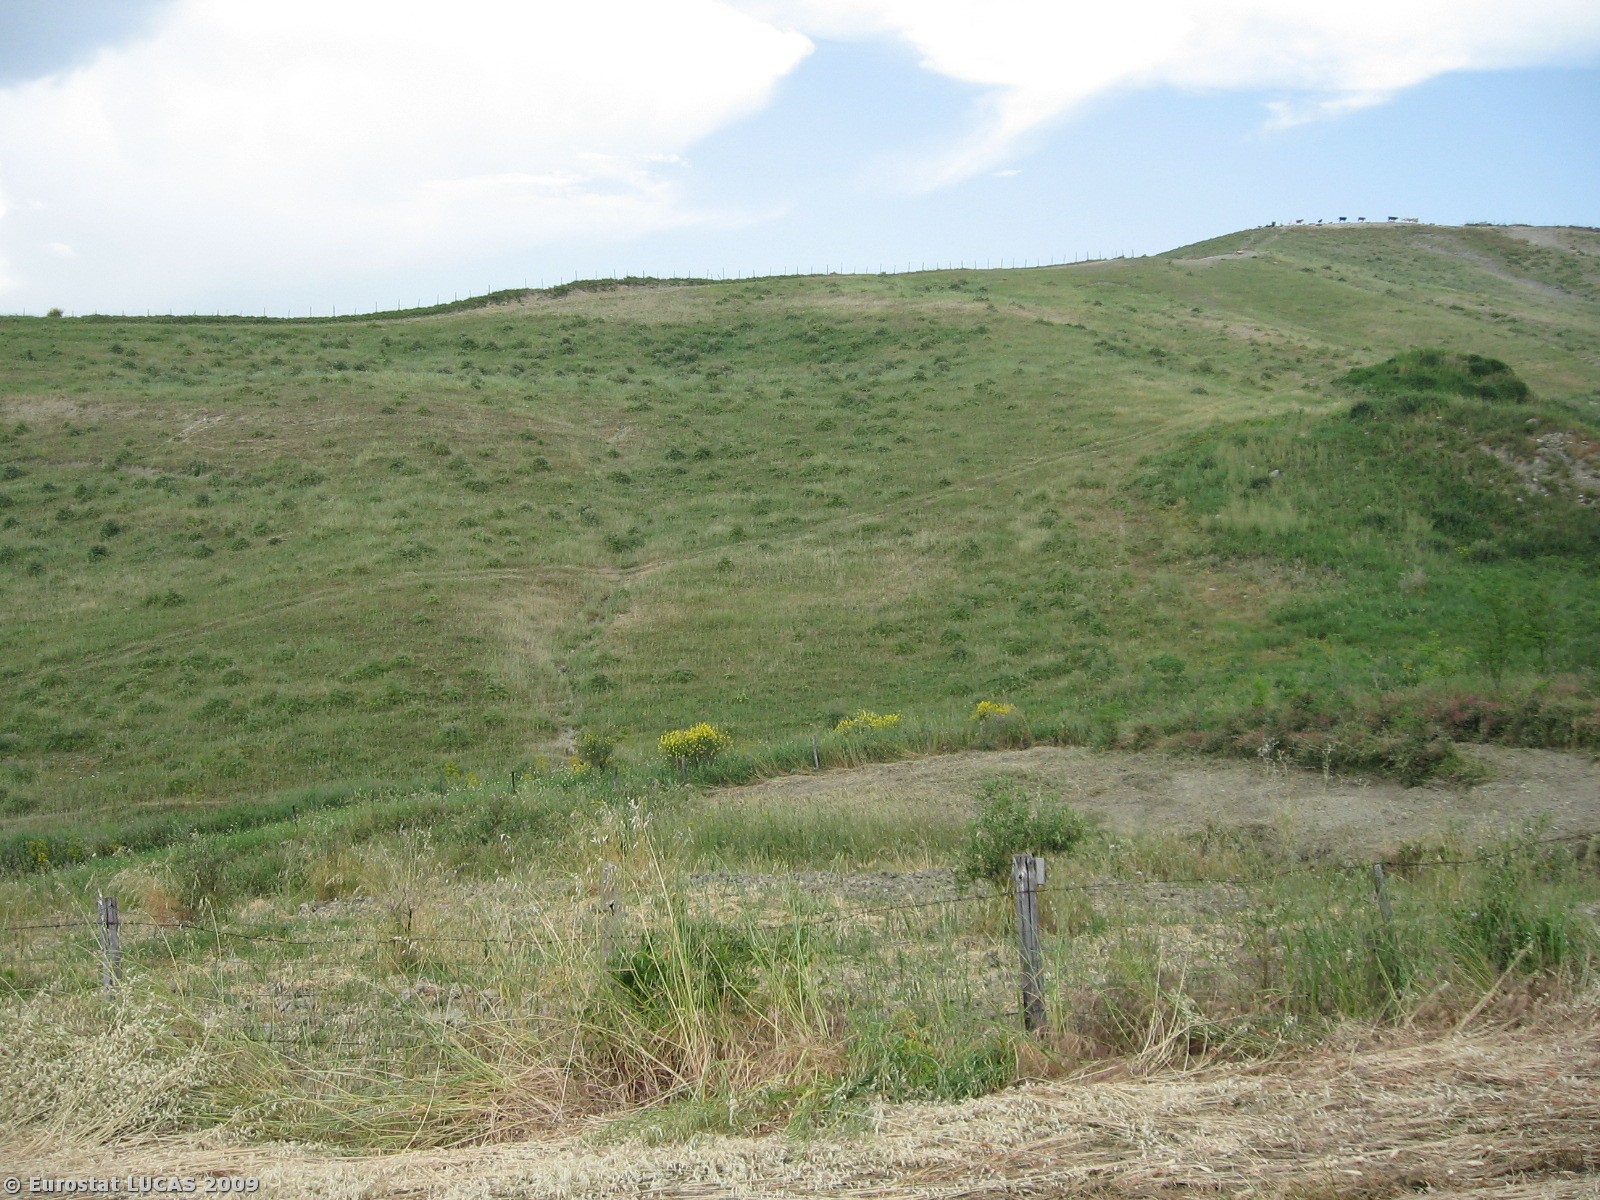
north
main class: Cropland
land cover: Temporary grasslands
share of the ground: > 75 %
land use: Agriculture (excluding fallow land and kitchen gardens)
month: May
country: IT
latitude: 39.0128
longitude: 16.8147
